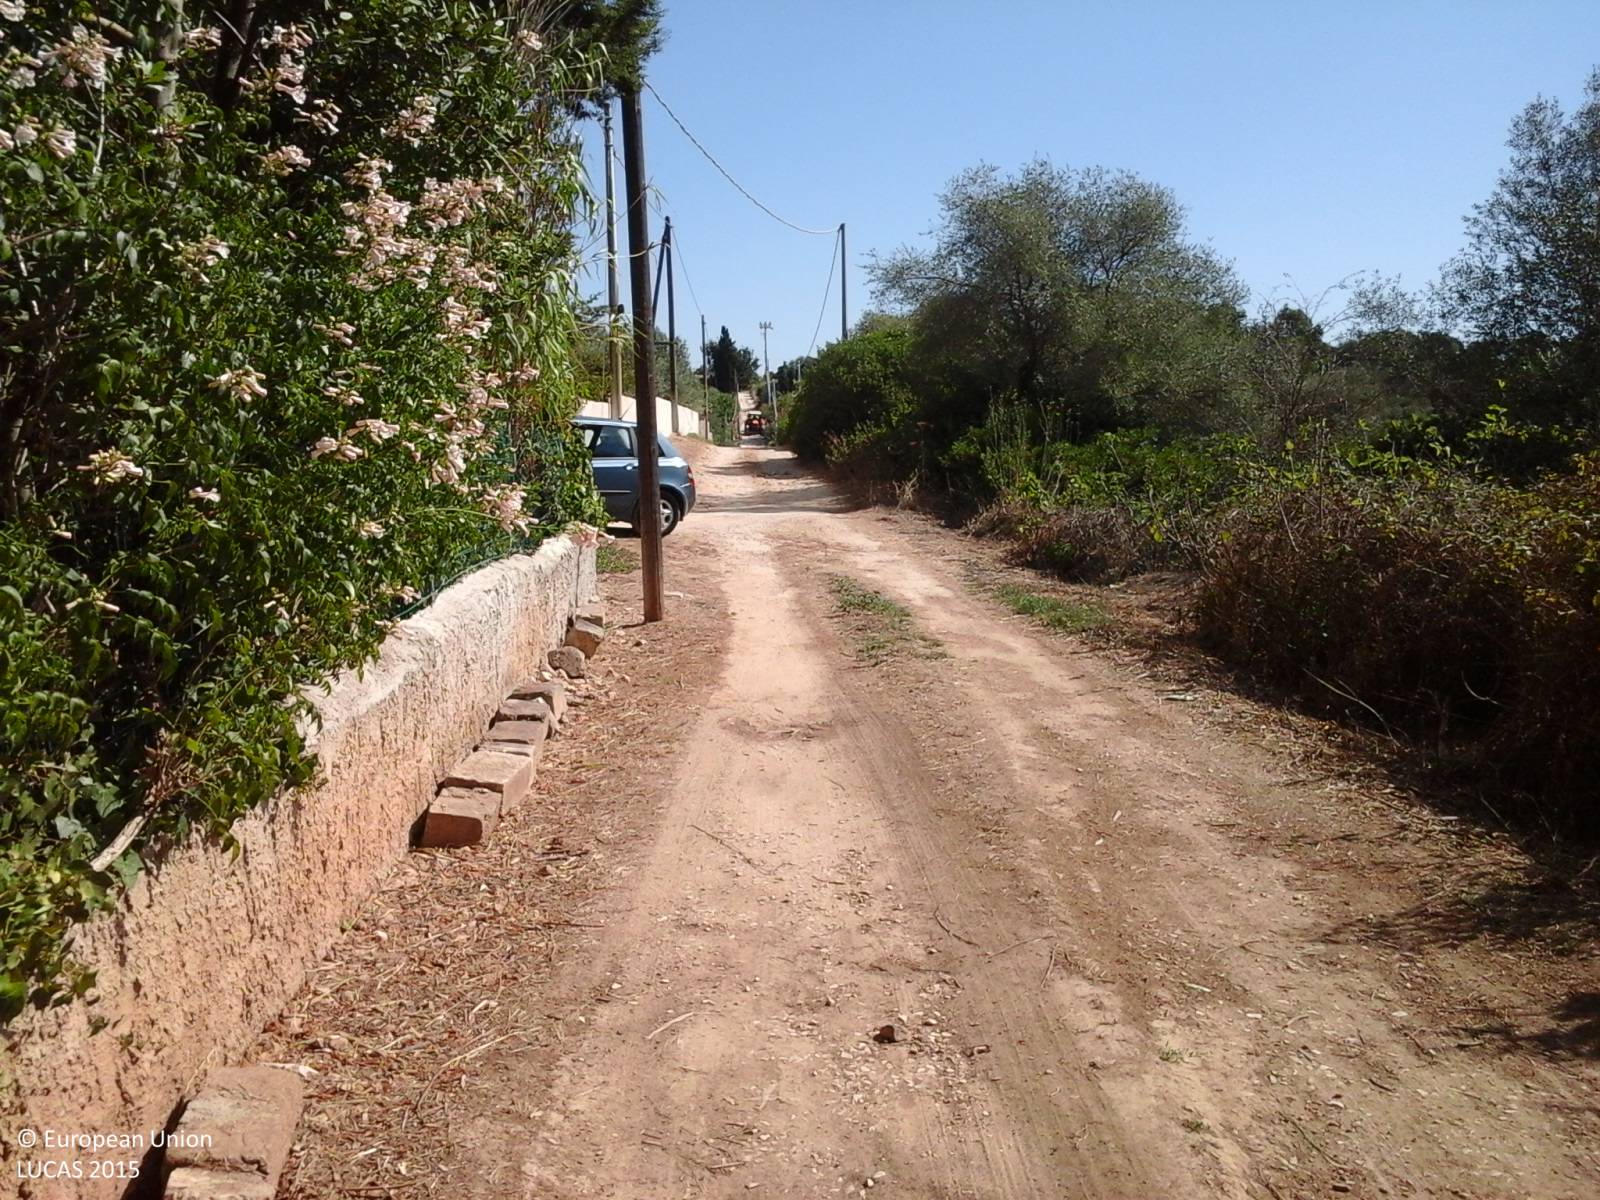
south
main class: Cropland
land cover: Other fruit trees and berries
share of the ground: 25 - 50 %
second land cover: Grassland without tree/shrub cover
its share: 10 - 25 %
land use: Kitchen garden
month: May
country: IT
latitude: 40.7258
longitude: 8.4564
